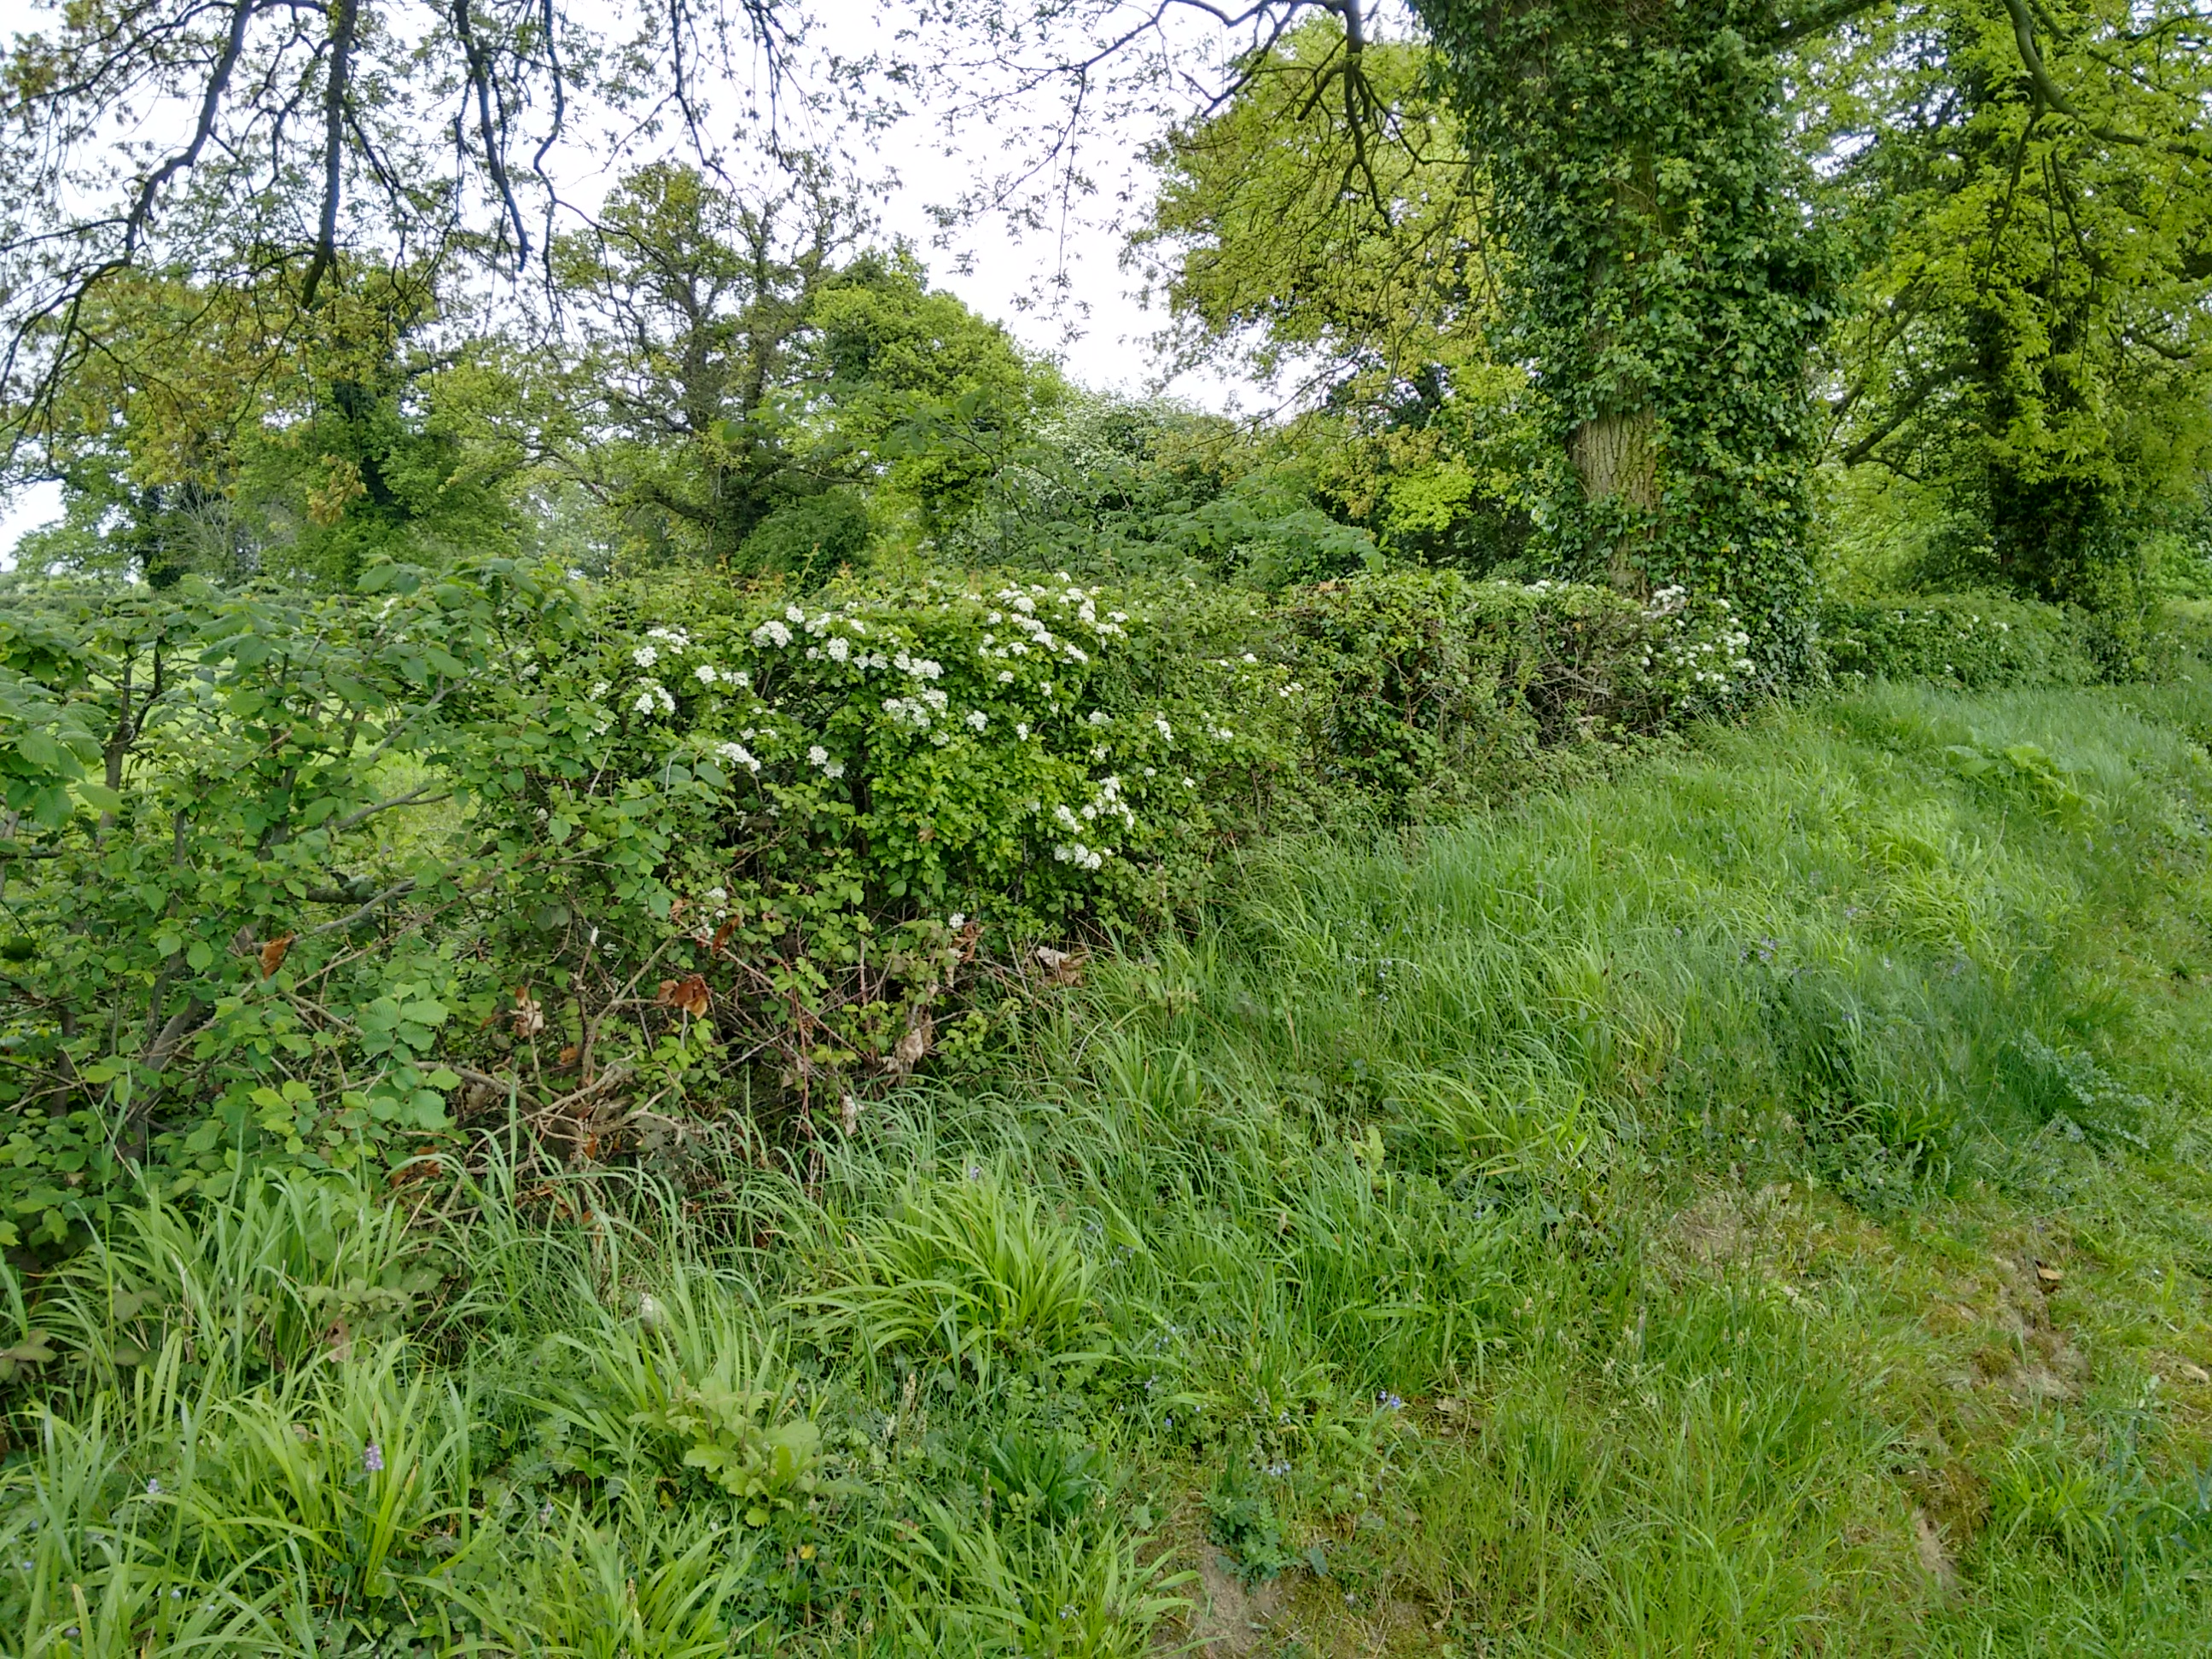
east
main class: Cropland
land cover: Barley
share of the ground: 50 - 75 %
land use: Agriculture (excluding fallow land and kitchen gardens)
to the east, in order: Barley; Ditches and canals; Managed hedges; Fences; Grassland without tree/shrub cover; Fences; Ditches and canals; Managed hedges; Grass margins; Paved roads, cycling and walking lanes; Grass margins; Managed hedges; Fences; Managed hedges; Grassland without tree/shrub cover; Fences; Grassland without tree/shrub cover
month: May
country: IE
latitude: 53.4014
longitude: -6.4751
